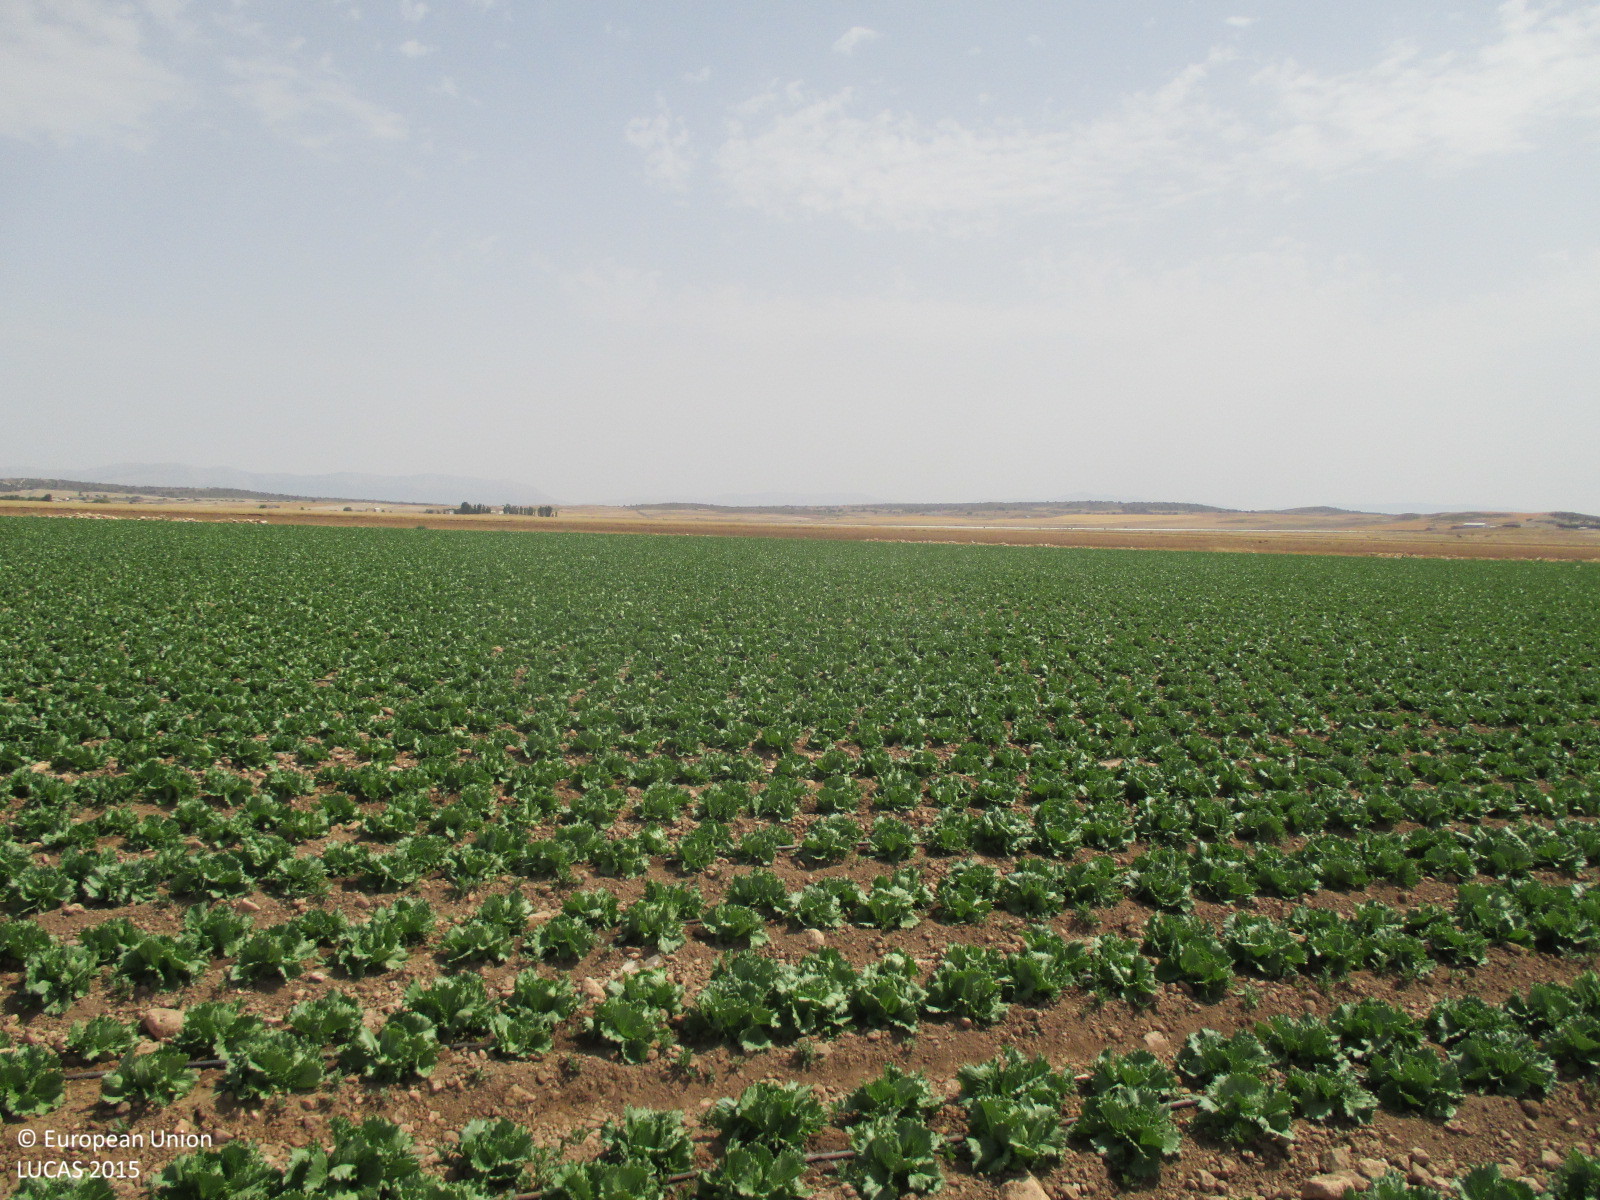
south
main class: Cropland
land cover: Other fresh vegetables
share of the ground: < 10 %
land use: Agriculture (excluding fallow land and kitchen gardens)
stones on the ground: 10 - 25 %
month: July
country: ES
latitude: 37.8977
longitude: -2.3055
